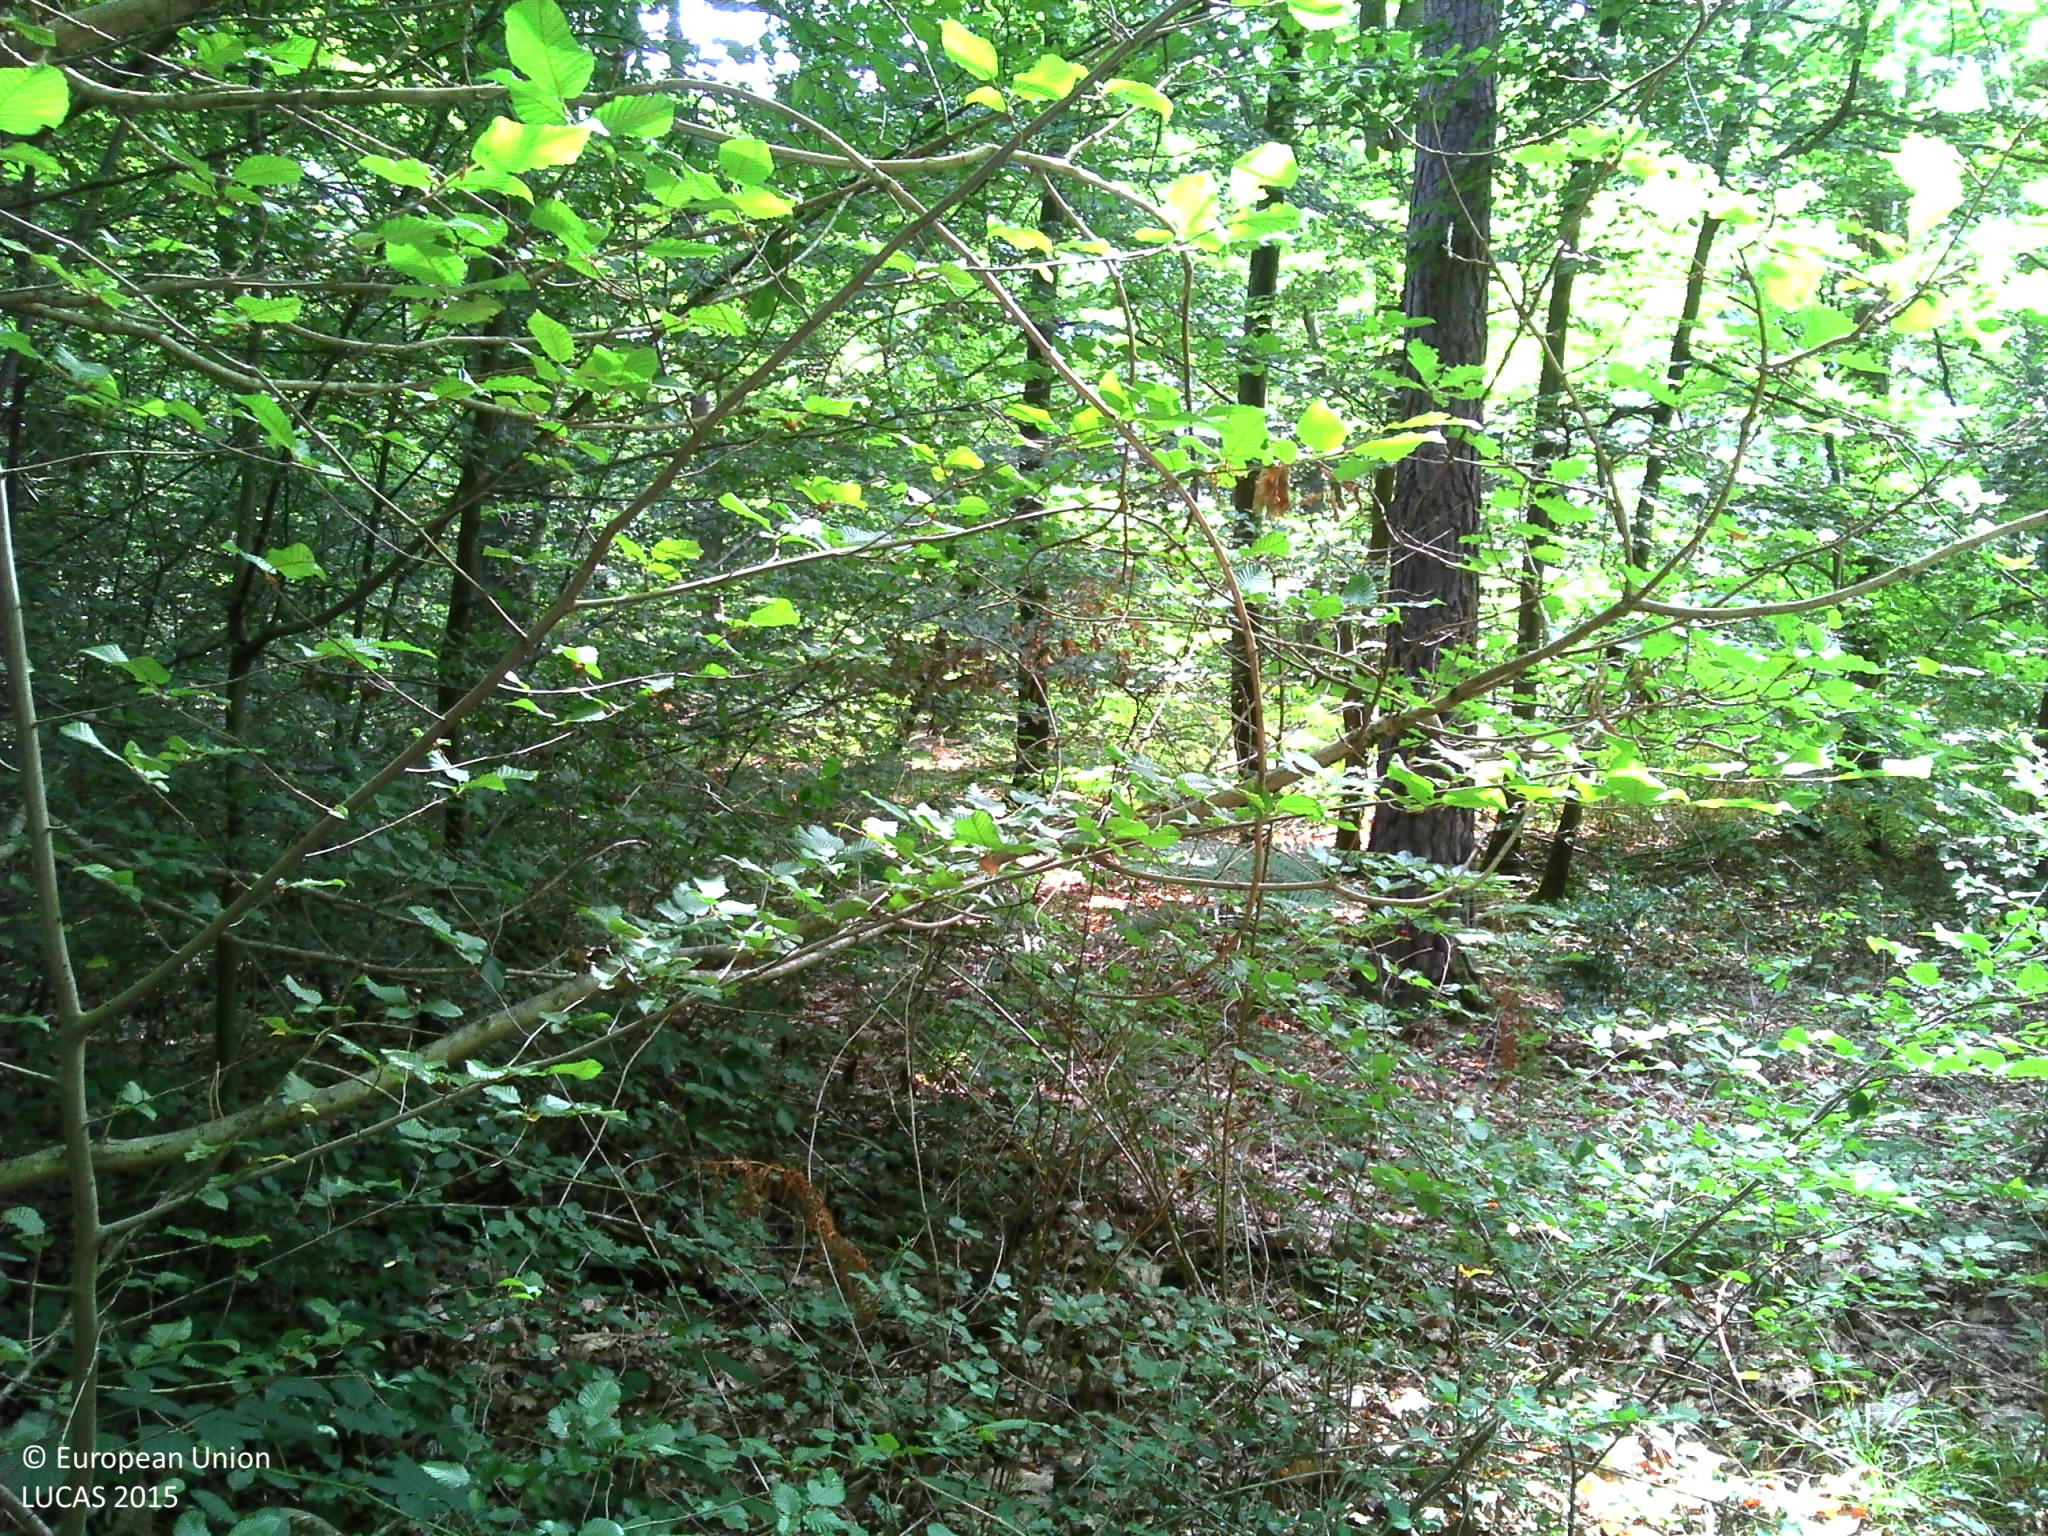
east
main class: Woodland
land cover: Broadleaved woodland
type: thermophilous deciduous forest
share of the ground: > 75 %
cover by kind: shrubs 40 %, broadleaved forest trees 30 %, unconsolidated bare surface 30 %
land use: Forestry
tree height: > 5 m
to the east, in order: Broadleaved woodland; Tracks; Broadleaved woodland; Tracks; Broadleaved woodland
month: August
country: FR
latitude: 48.3994
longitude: 2.7375
